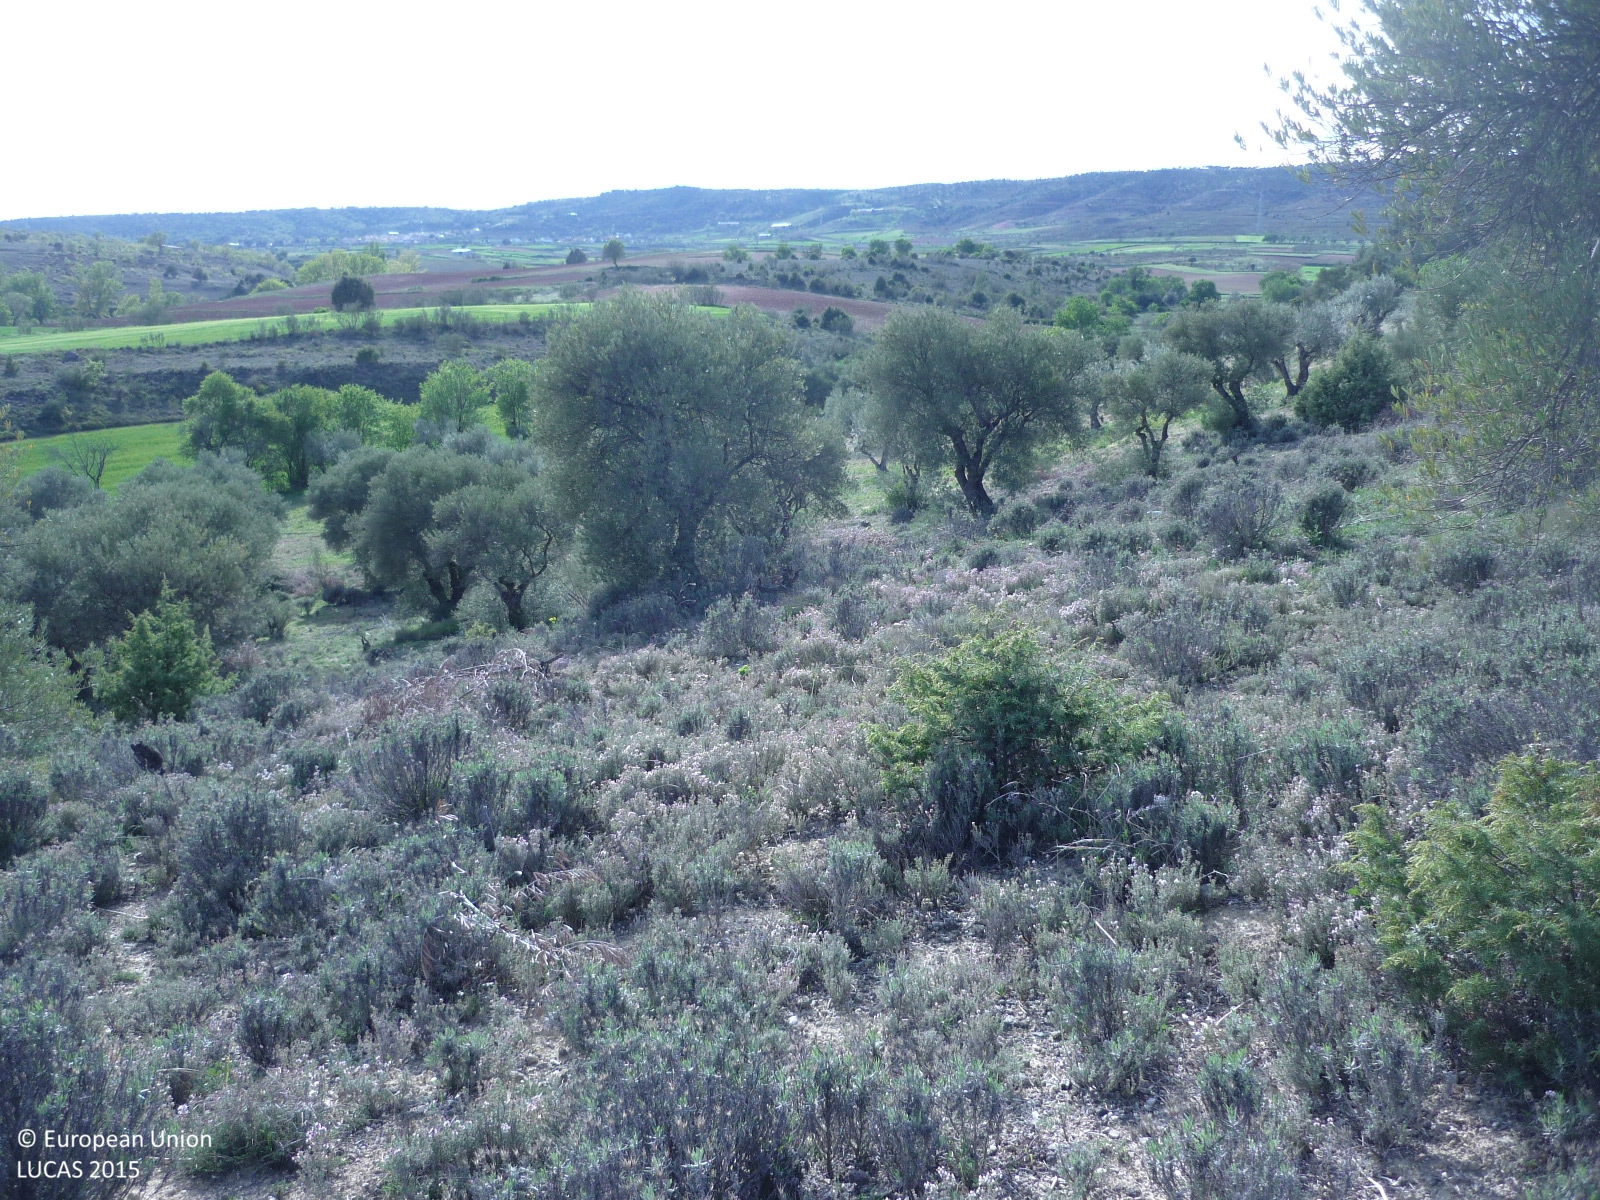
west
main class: Cropland
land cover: Olive groves
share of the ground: 25 - 50 %
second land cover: Shrubland without tree cover
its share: 50 - 75 %
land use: Abandoned areas
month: April
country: ES
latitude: 40.8214
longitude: -3.5692
